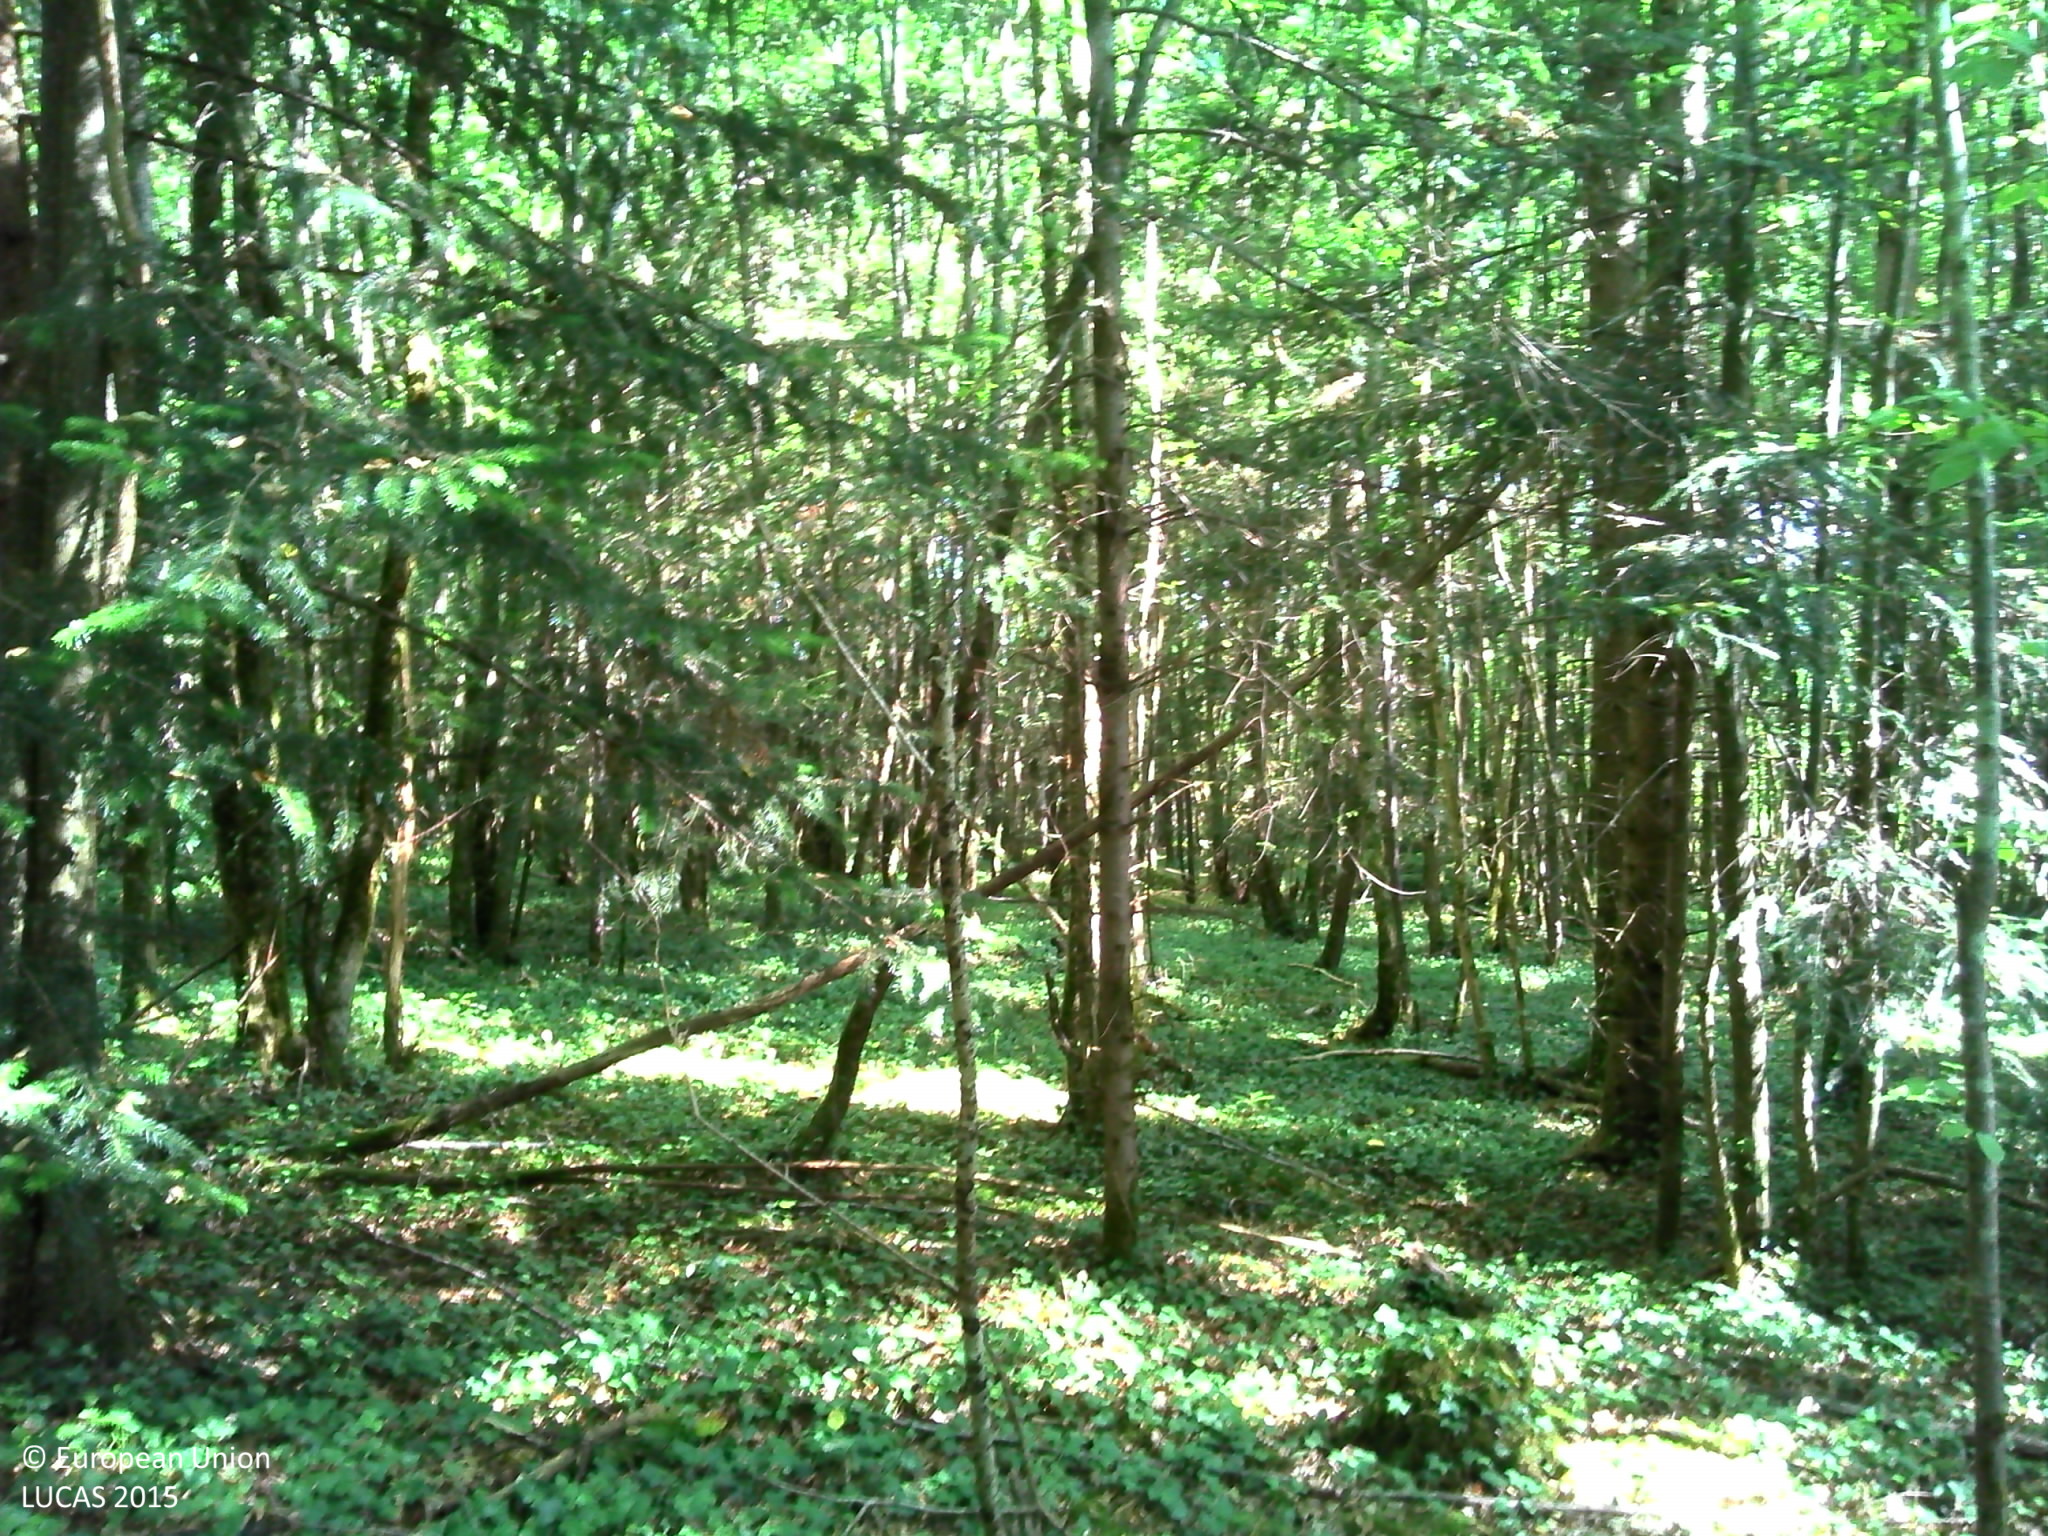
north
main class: Woodland
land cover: Pine dominated coniferous woodland
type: hemiboreal forest and nemoral coniferous forest and mixed broadleaved-coniferous forest
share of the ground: > 75 %
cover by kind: coniferous forest trees 80 %, herbaceous plants 10 %, shrubs 5 %, lichens and mosses 5 %
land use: Forestry
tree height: > 5 m
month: August
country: FR
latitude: 44.7716
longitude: 0.7557
